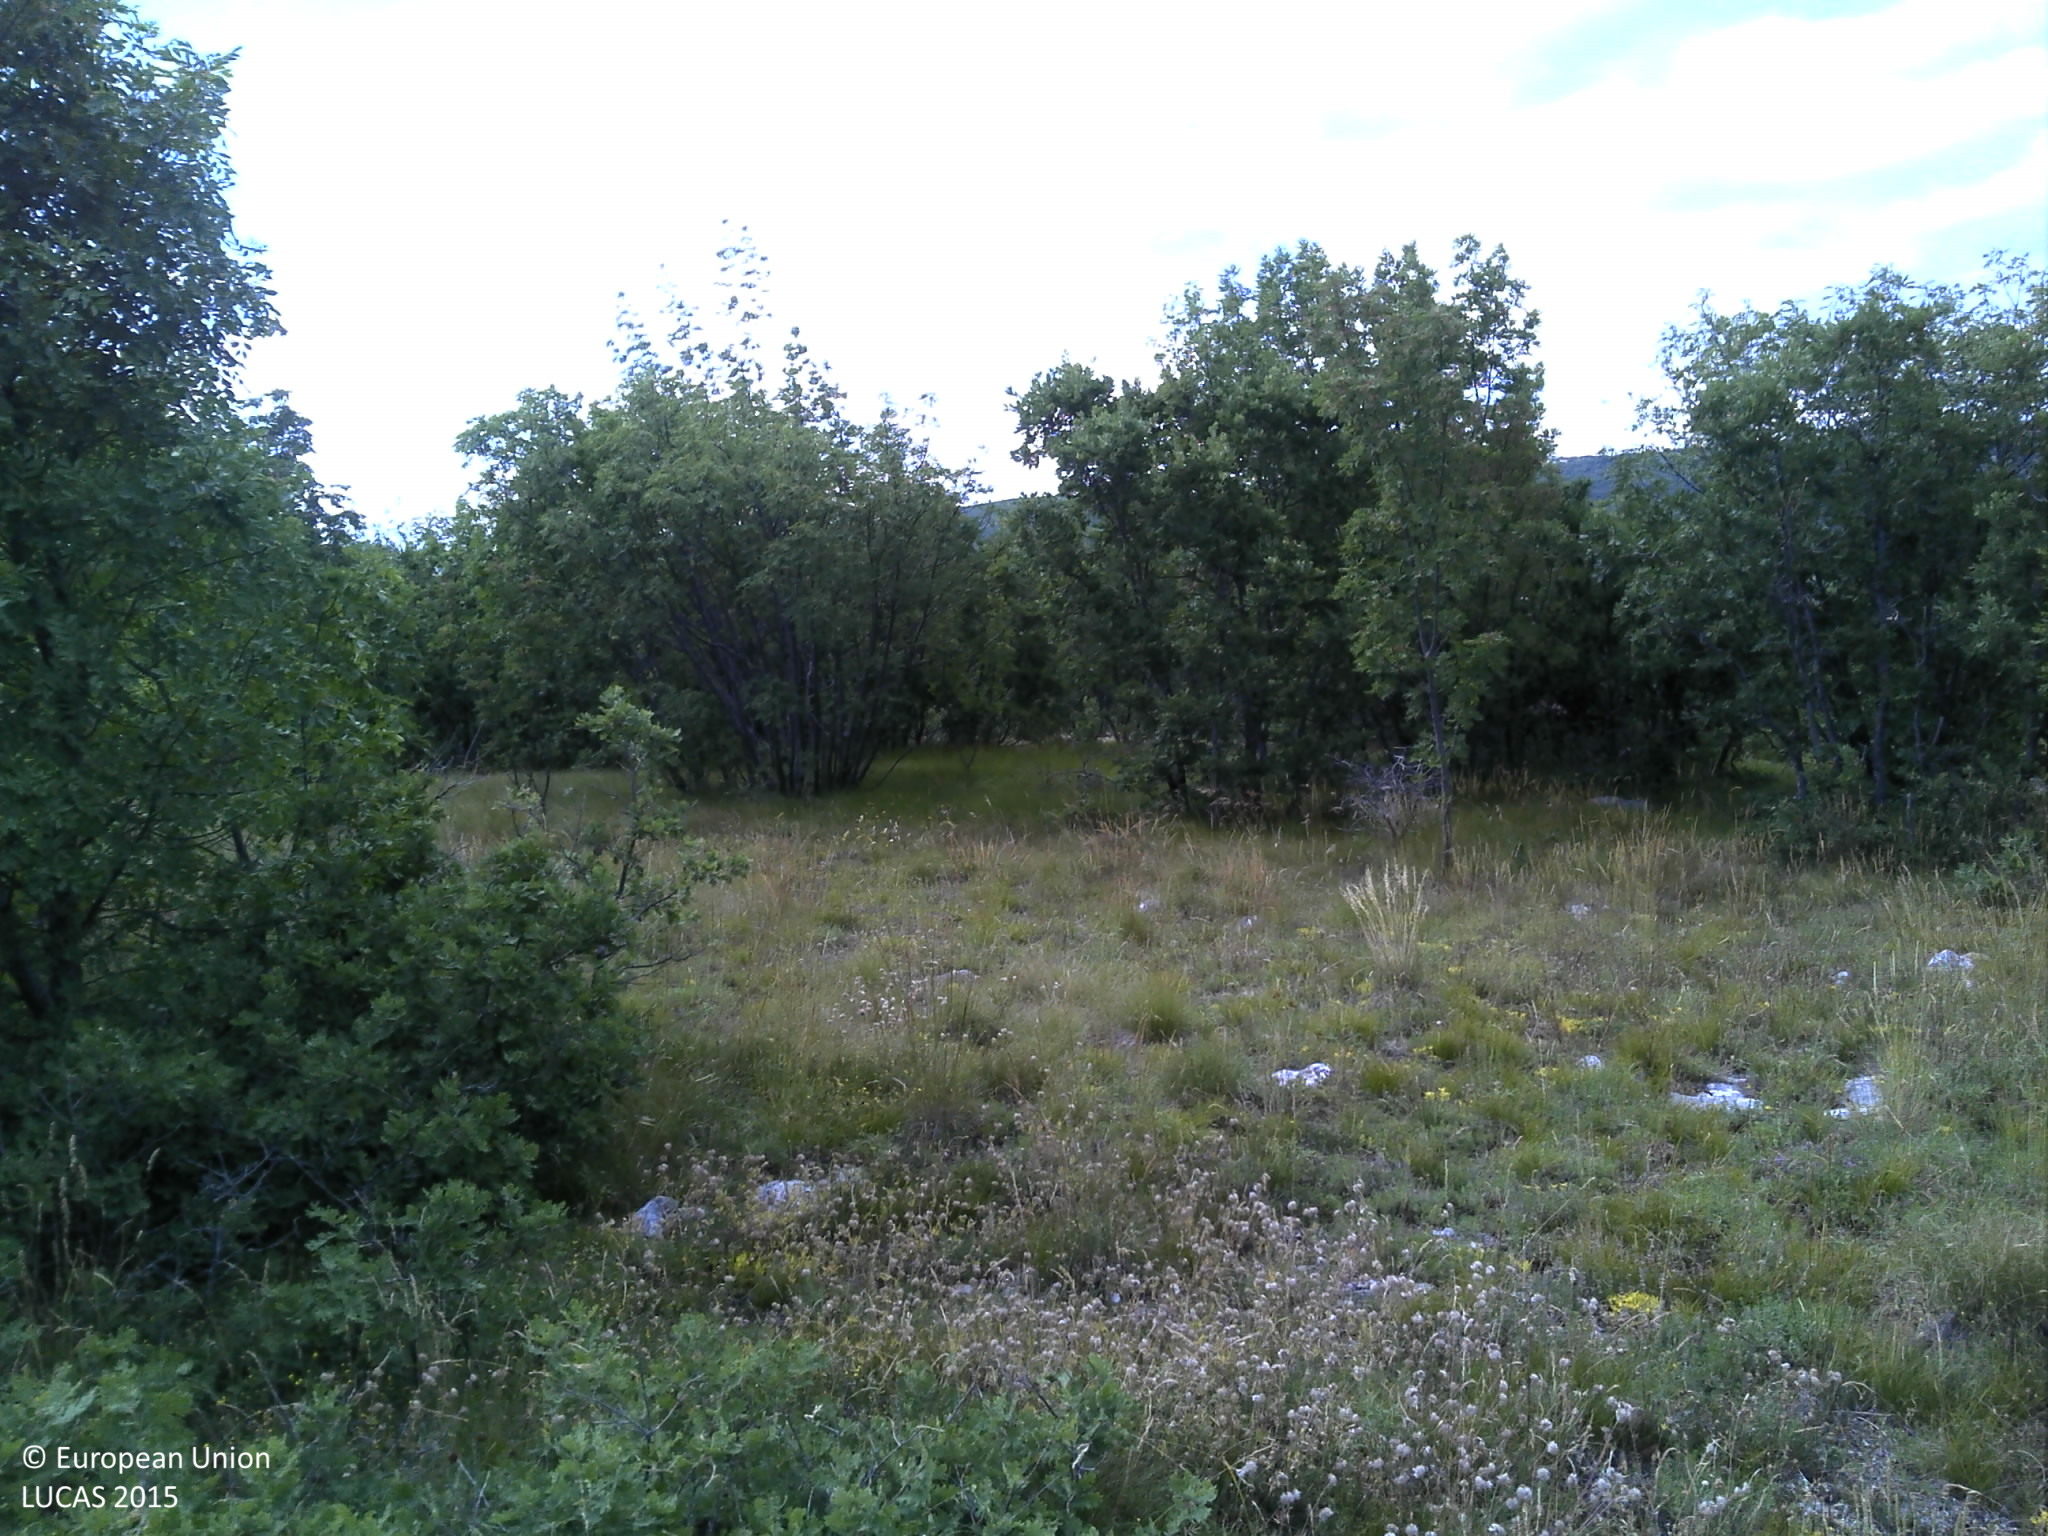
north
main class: Woodland
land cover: Broadleaved woodland
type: thermophilous deciduous forest
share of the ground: 25 - 50 %
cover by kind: broadleaved forest trees 35 %, herbaceous plants 30 %, shrubs 20 %, unconsolidated bare surface 10 %, consolidated bare surface 5 %
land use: Semi-natural and natural areas not in use
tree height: > 5 m
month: June
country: HR
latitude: 43.6110
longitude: 16.9430
